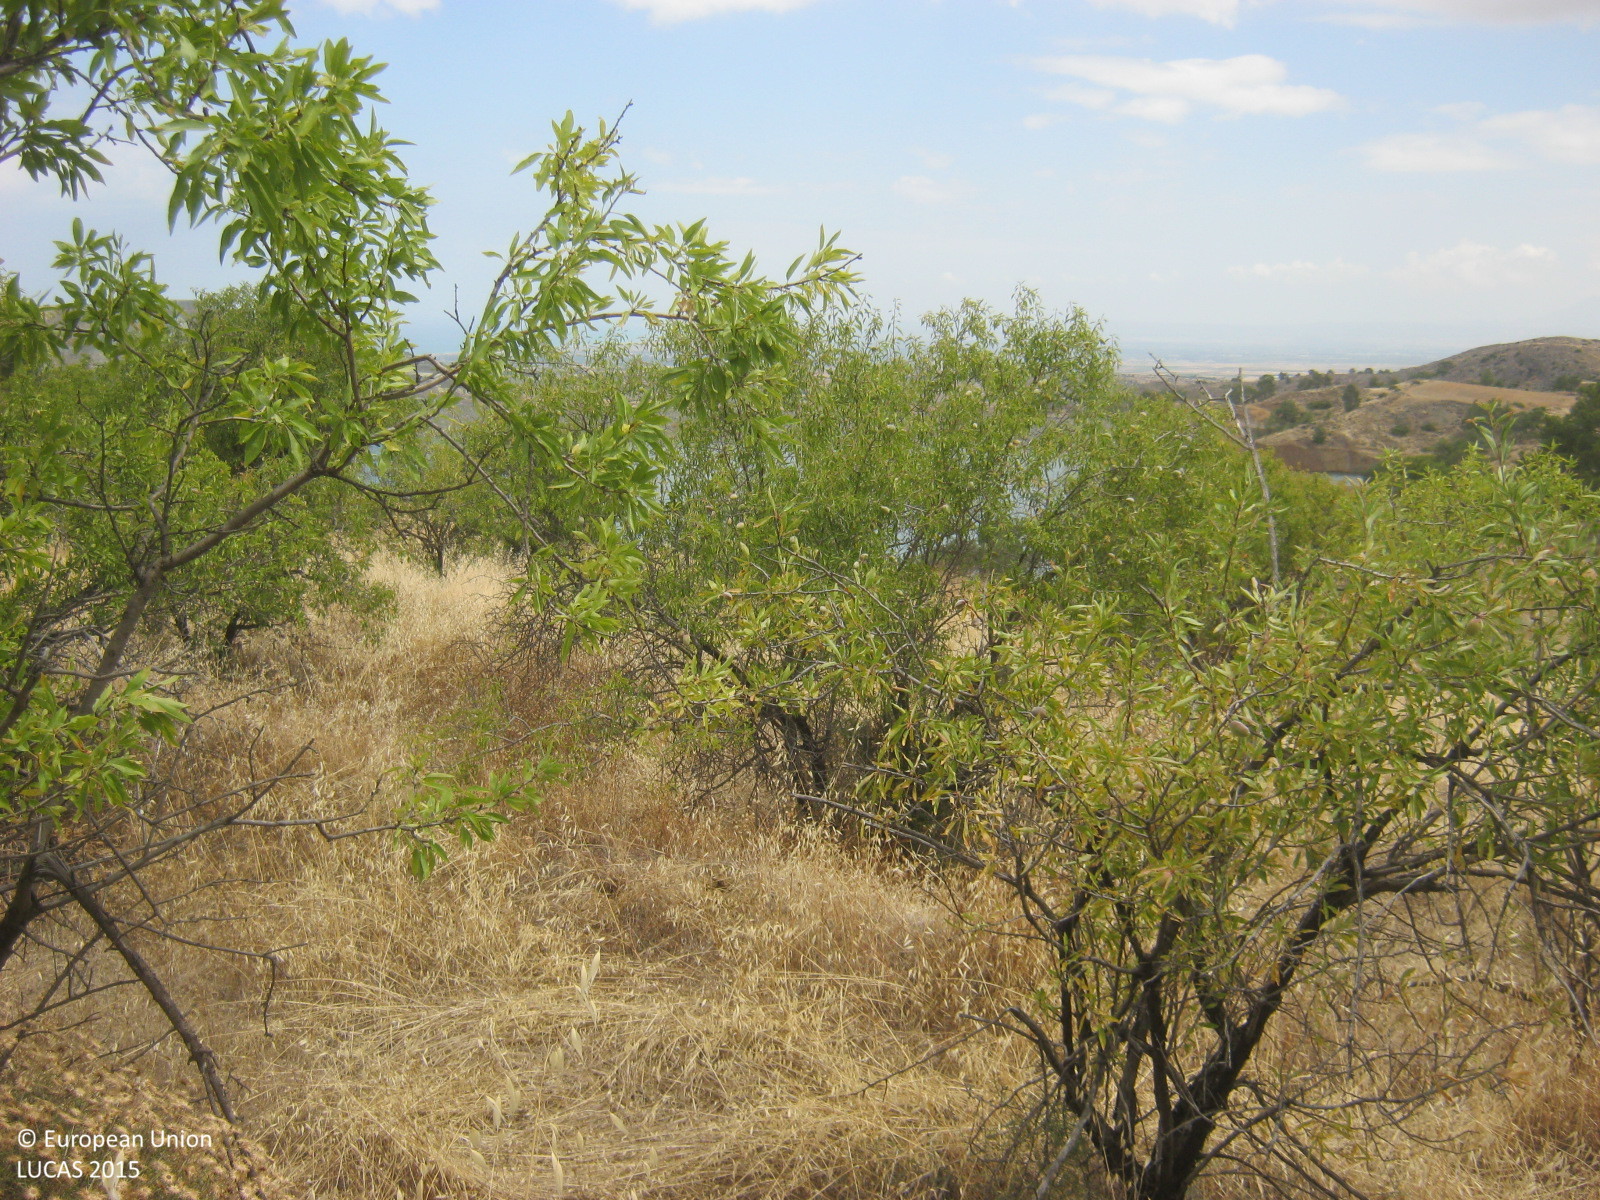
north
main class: Cropland
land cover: Nuts trees
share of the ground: 25 - 50 %
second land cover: Grassland without tree/shrub cover
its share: > 75 %
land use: Agriculture (excluding fallow land and kitchen gardens)
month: June
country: CY
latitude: 35.0625
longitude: 32.9028
